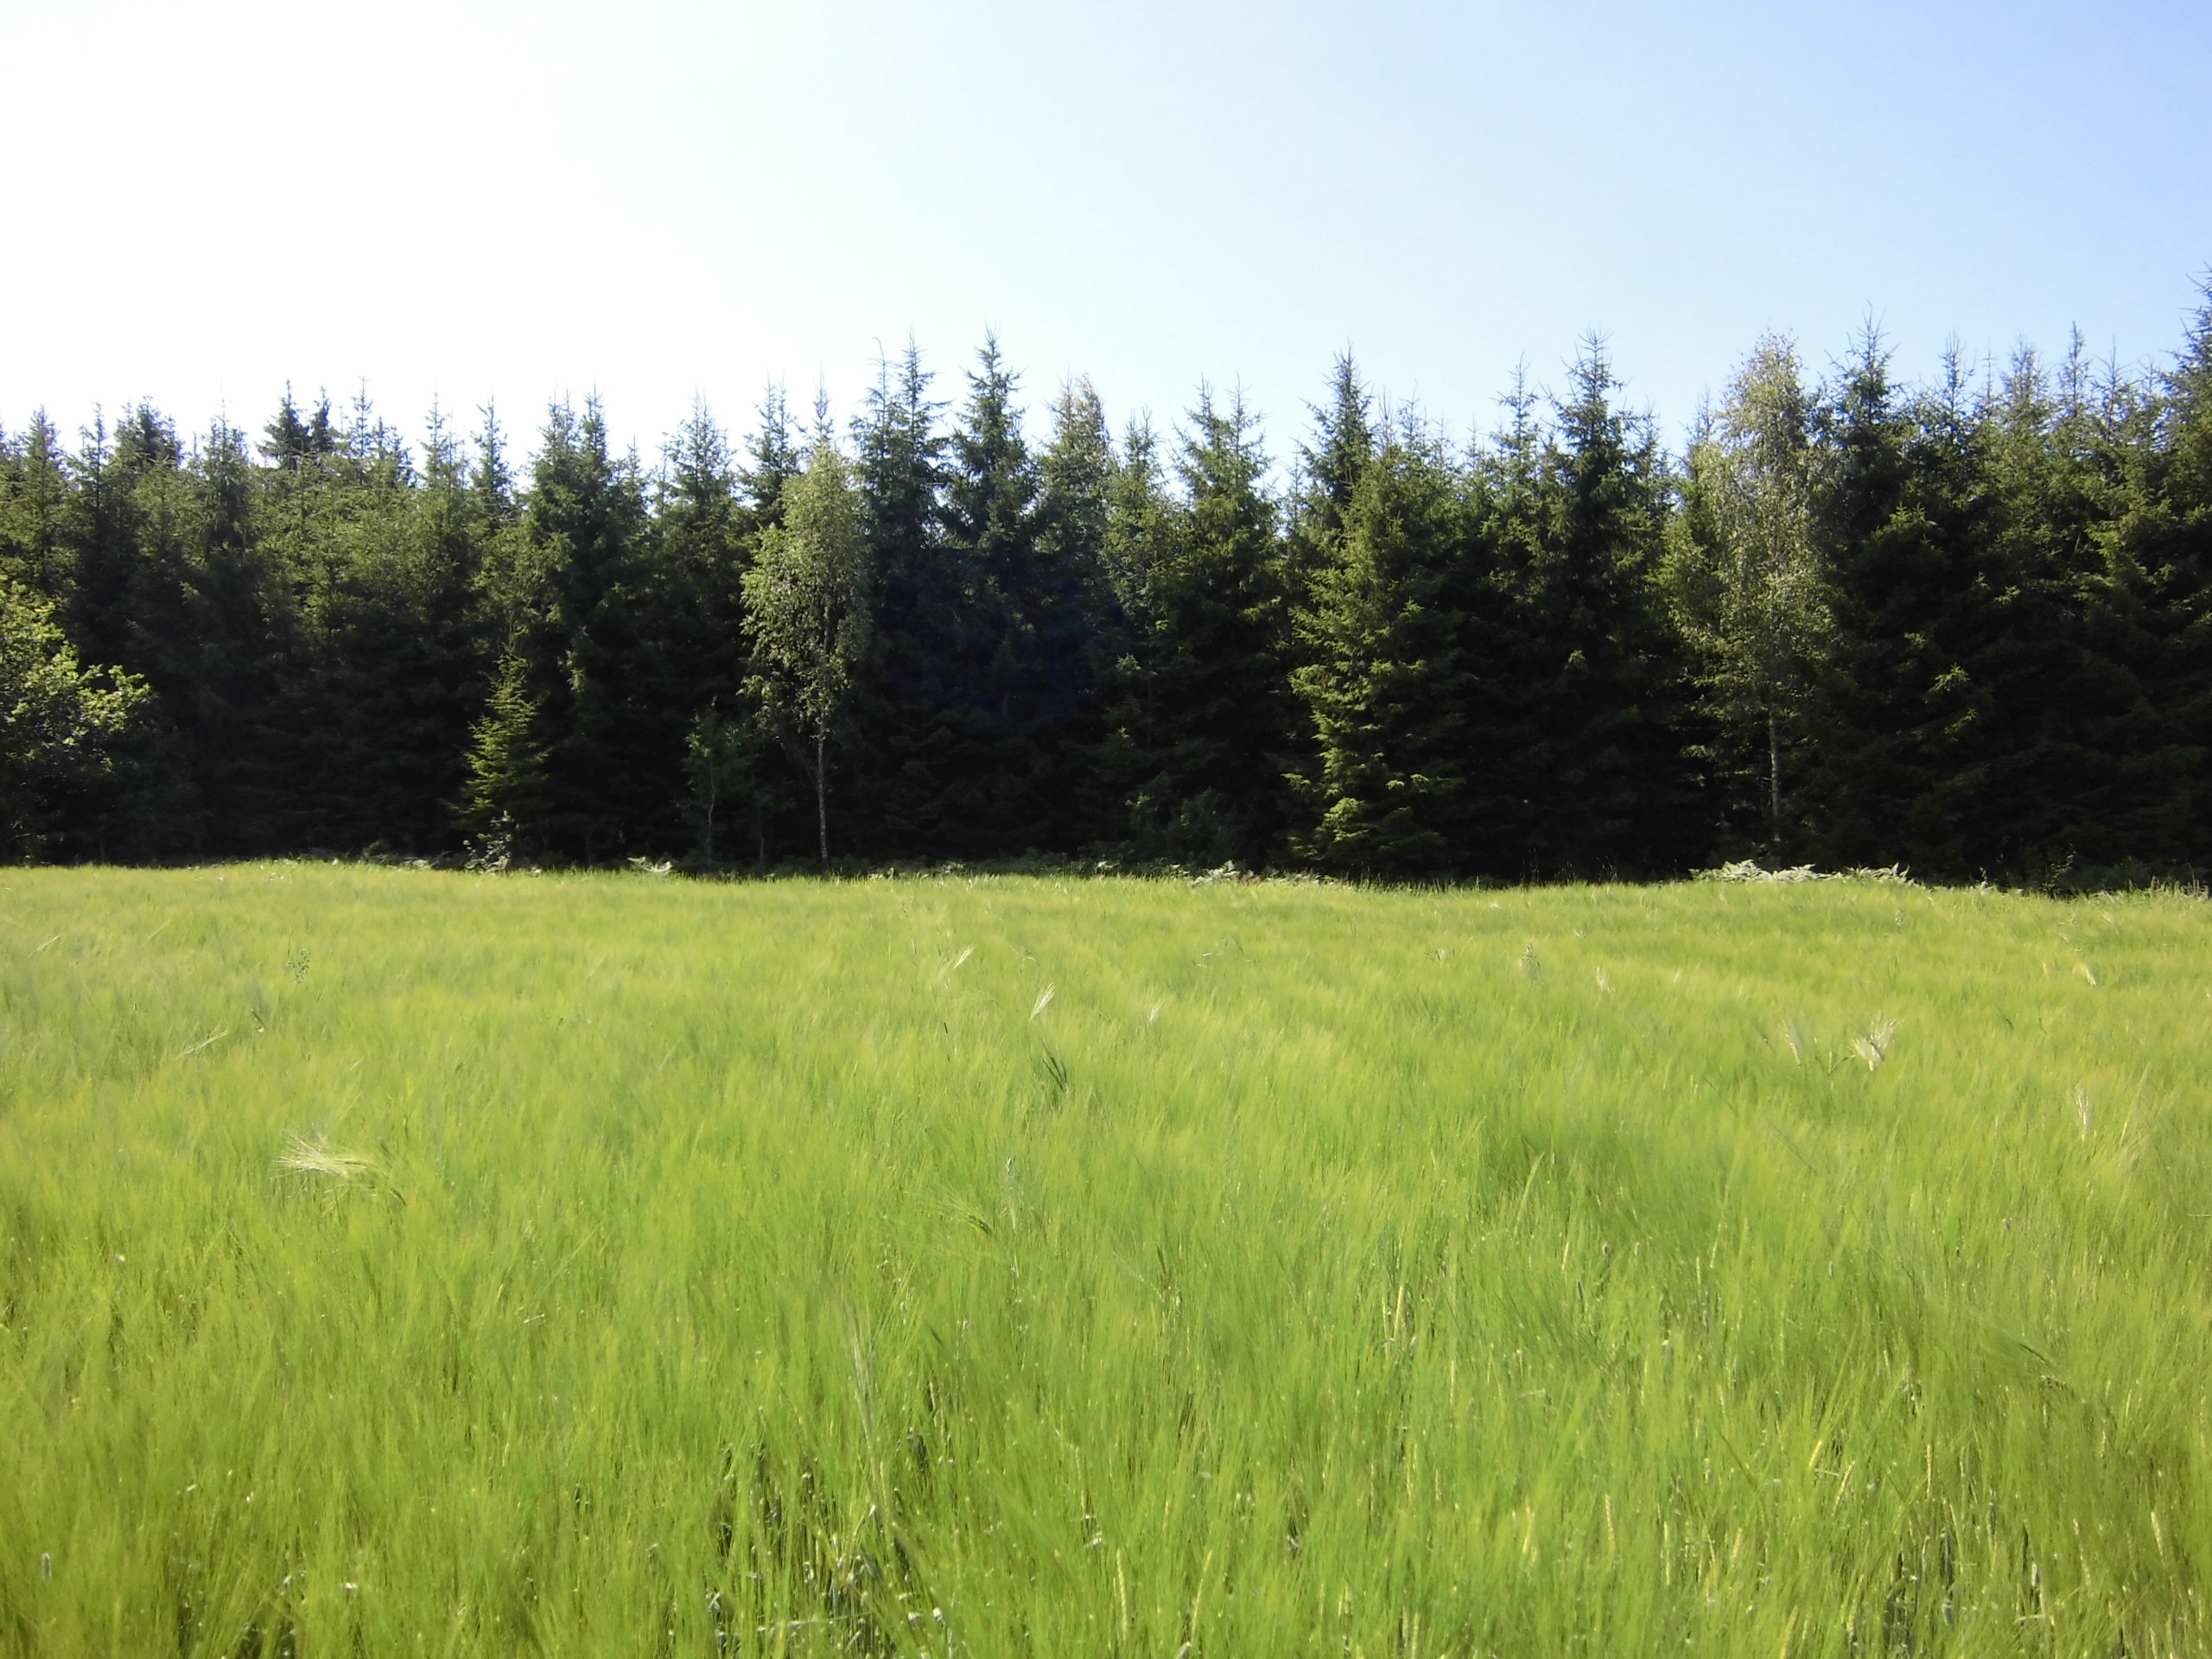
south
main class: Cropland
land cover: Barley
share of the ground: > 75 %
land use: Agriculture (excluding fallow land and kitchen gardens)
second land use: Amenities, museums, leisure
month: July
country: SE
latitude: 57.3221
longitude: 15.2943
